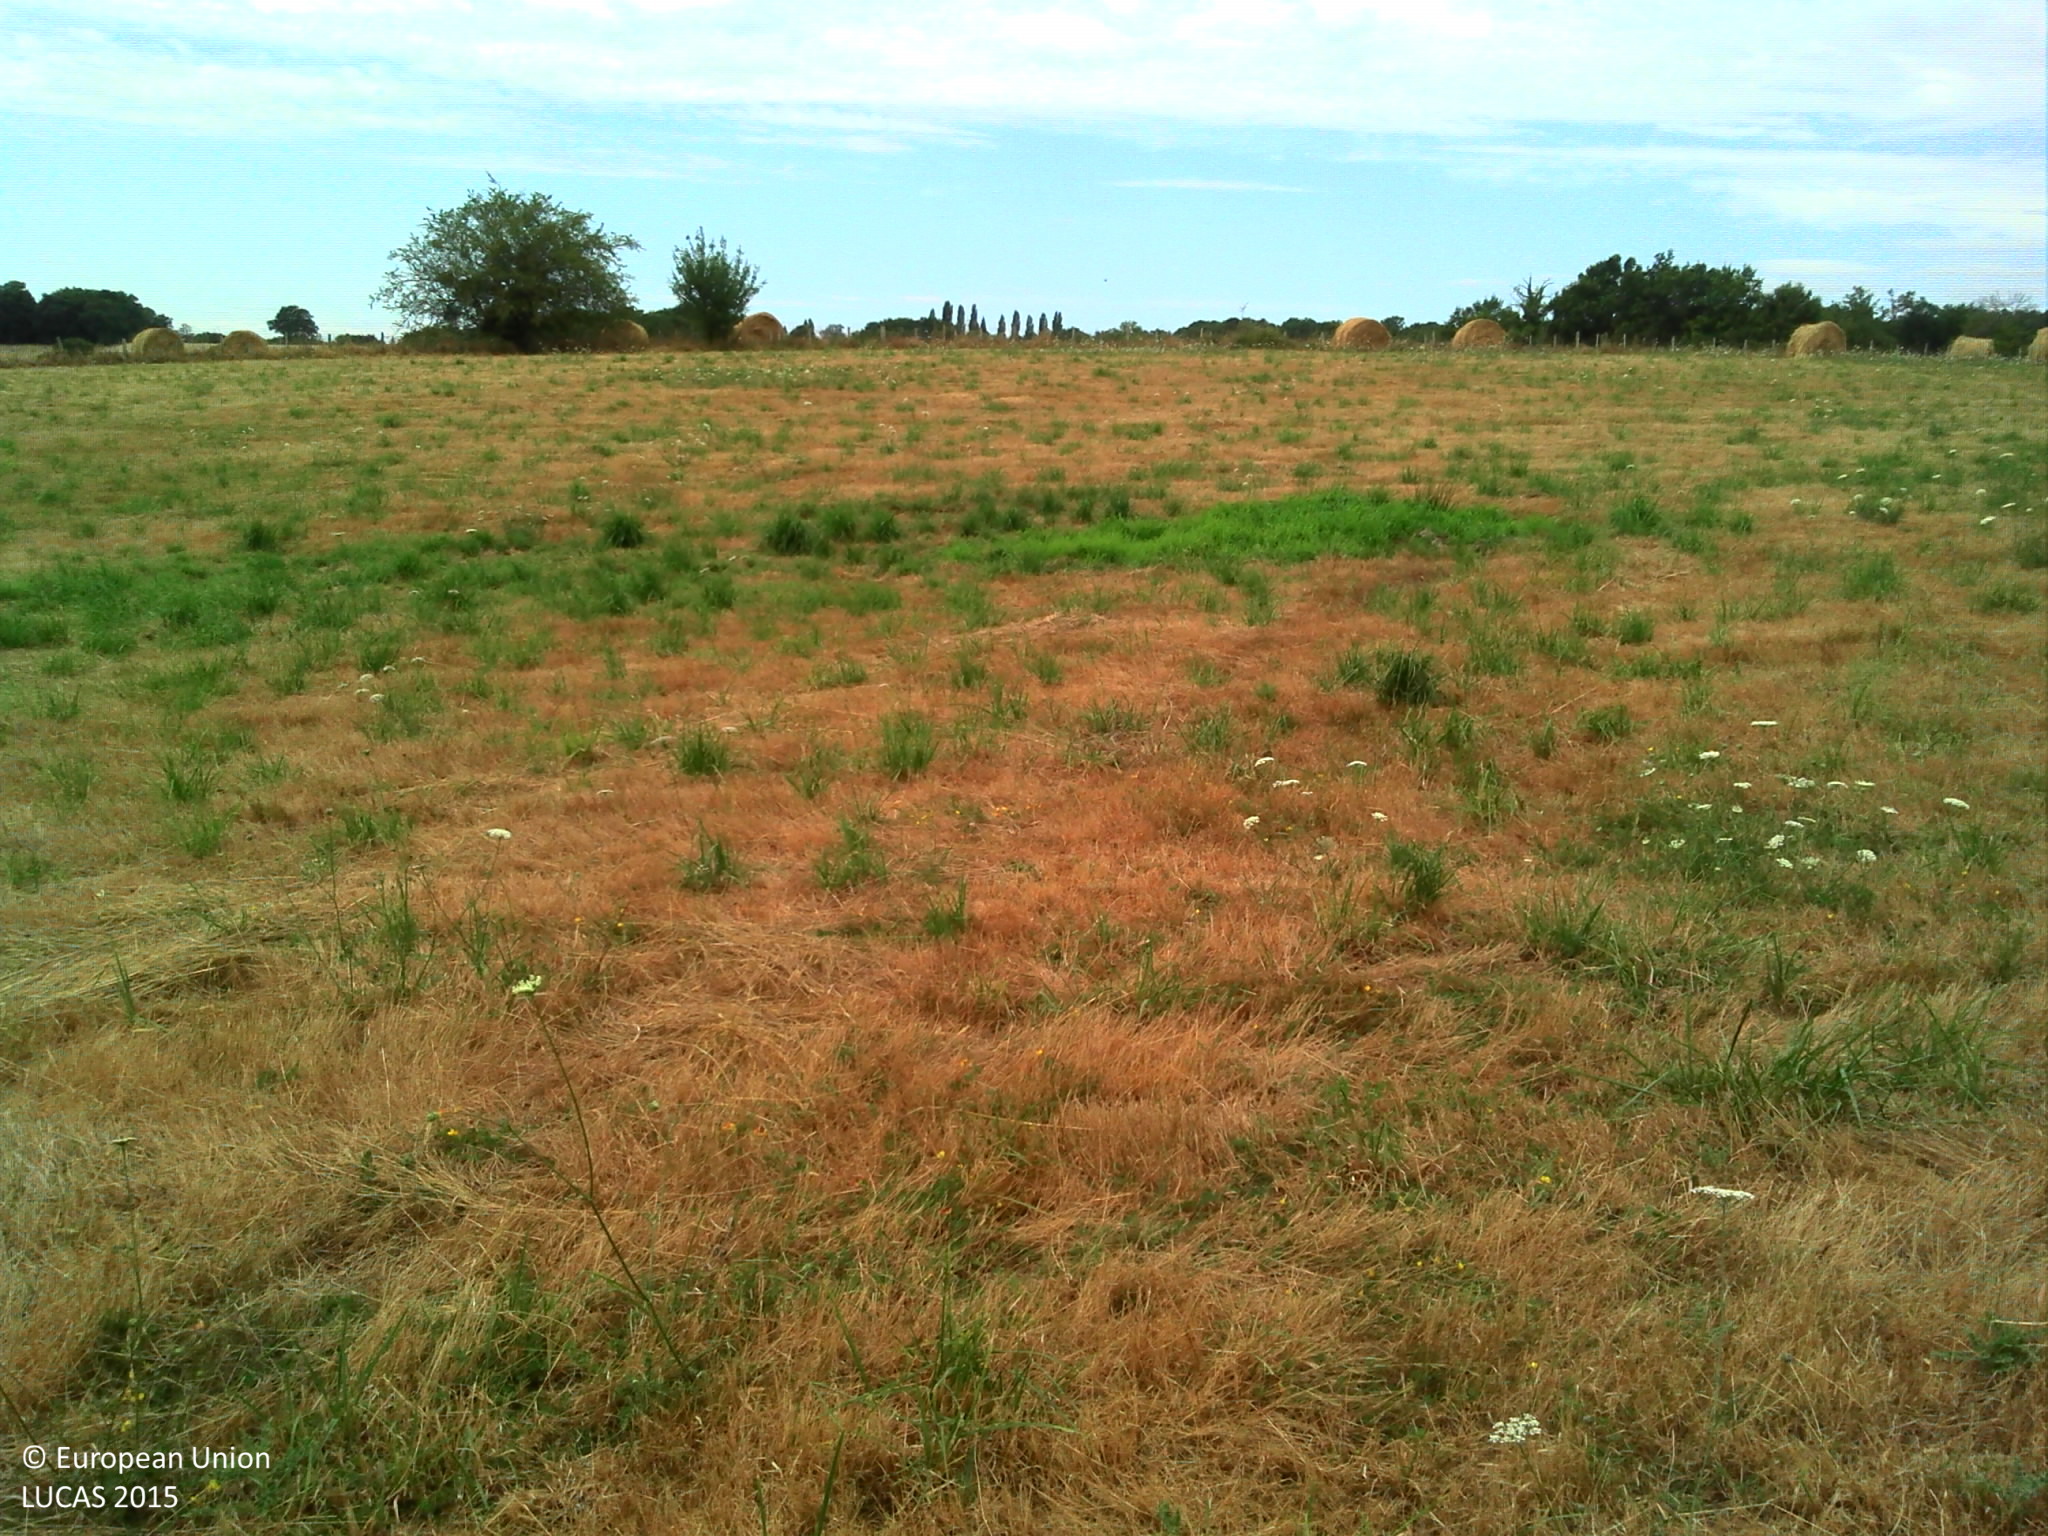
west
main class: Grassland
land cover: Grassland without tree/shrub cover
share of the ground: > 75 %
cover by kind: herbaceous plants 95 %, shrubs 5 %
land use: Agriculture (excluding fallow land and kitchen gardens)
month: July
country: FR
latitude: 45.8948
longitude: 0.9540
